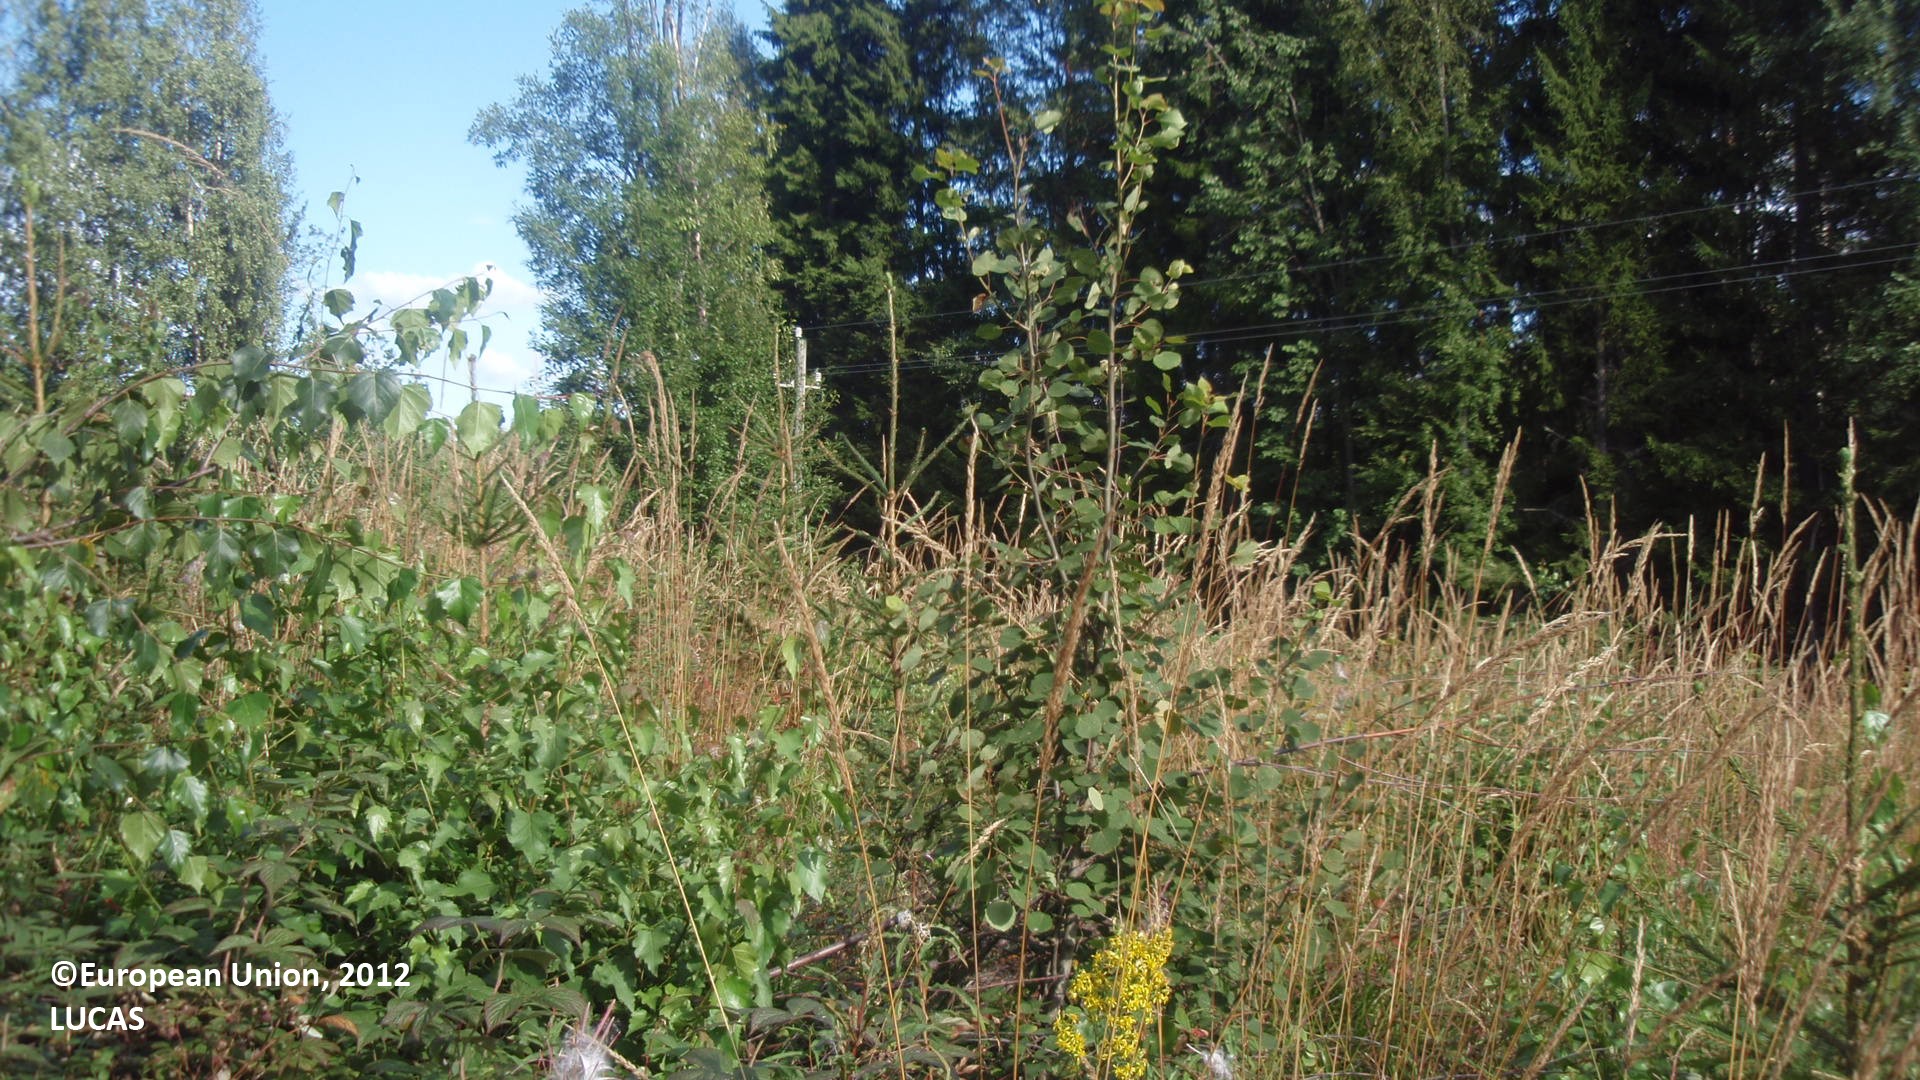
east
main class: Shrubland
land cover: Shrubland with sparse tree cover
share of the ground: > 75 %
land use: Forestry
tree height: < 5 m
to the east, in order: Shrubland with sparse tree cover; Paved roads, cycling and walking lanes; Shrubland with sparse tree cover; Electric lines; Shrubland with sparse tree cover; Temporary grasslands; Broadleaved woodland; Ditches and canals; Shrubland with sparse tree cover; Mixed cereals for fodder
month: August
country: FI
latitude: 61.5539
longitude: 27.6656
